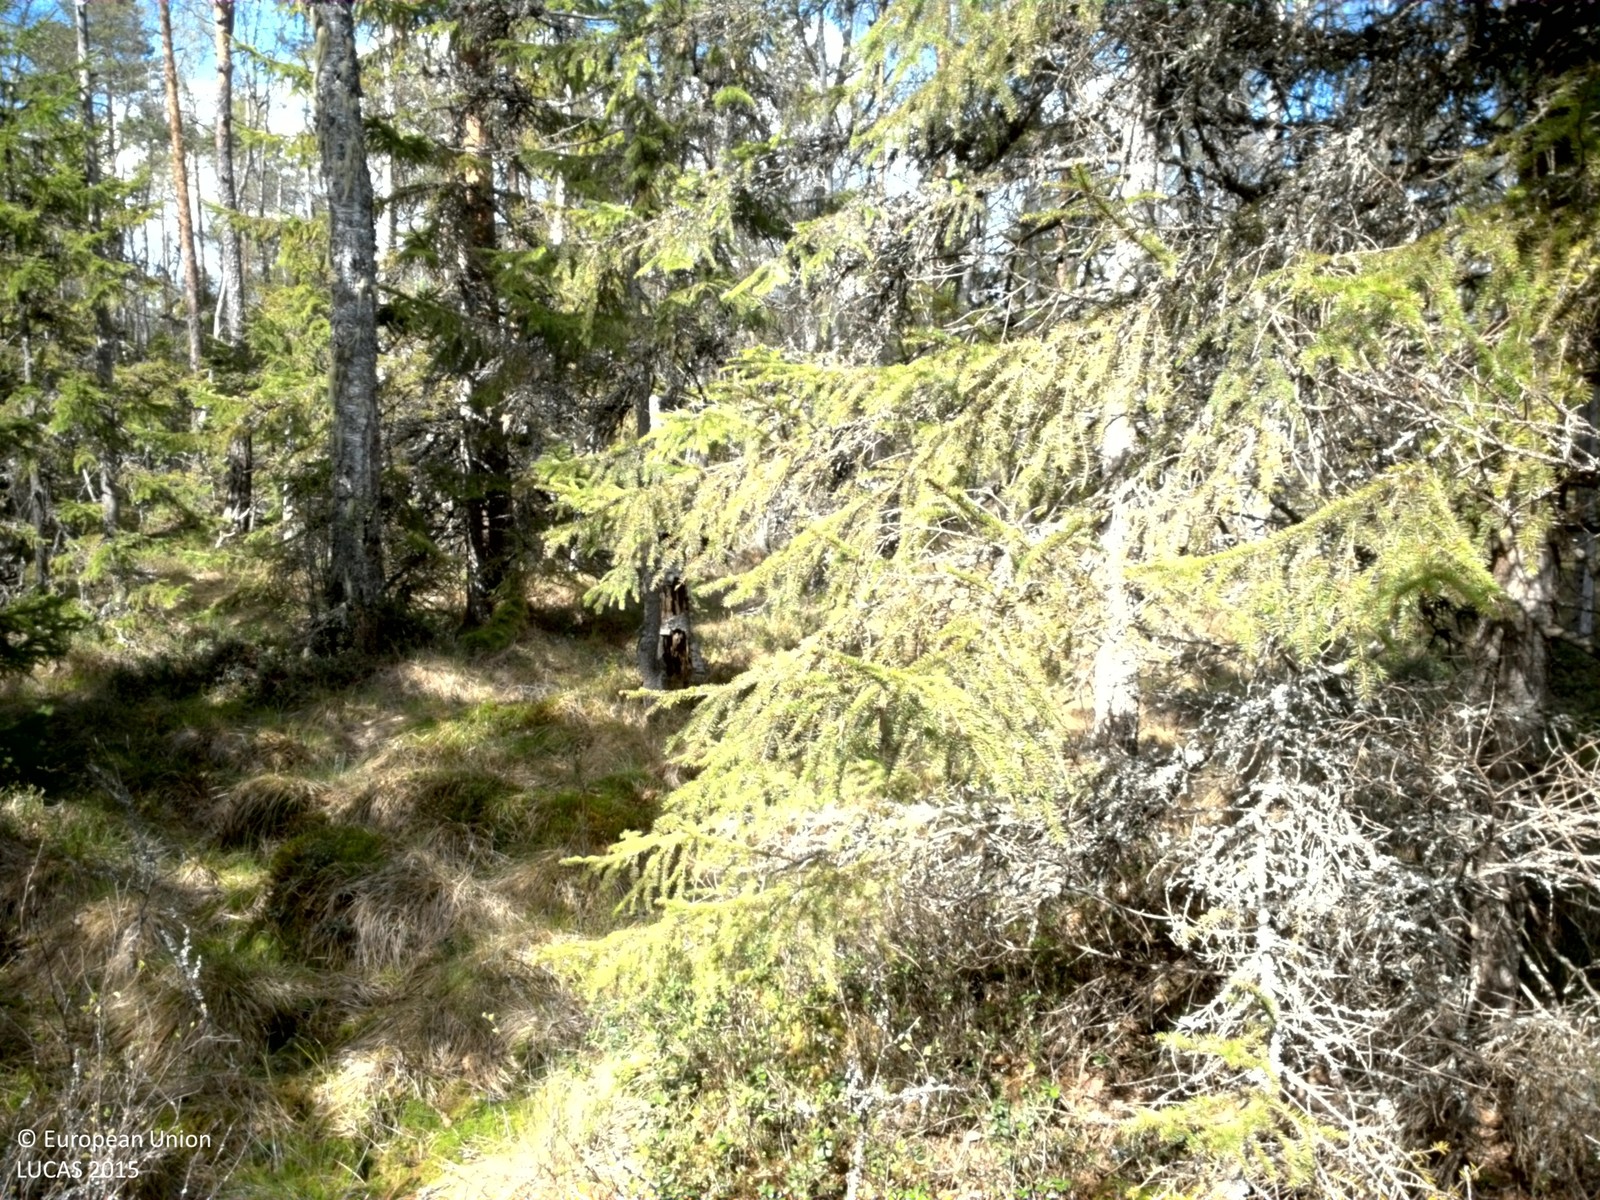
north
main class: Woodland
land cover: Spruce dominated mixed woodland
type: boreal forest
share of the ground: > 75 %
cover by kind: coniferous forest trees 60 %, broadleaved forest trees 20 %, lichens and mosses 10 %, shrubs 5 %, herbaceous plants 5 %
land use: Forestry
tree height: > 5 m
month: May
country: SE
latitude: 59.1561
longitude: 14.4160
